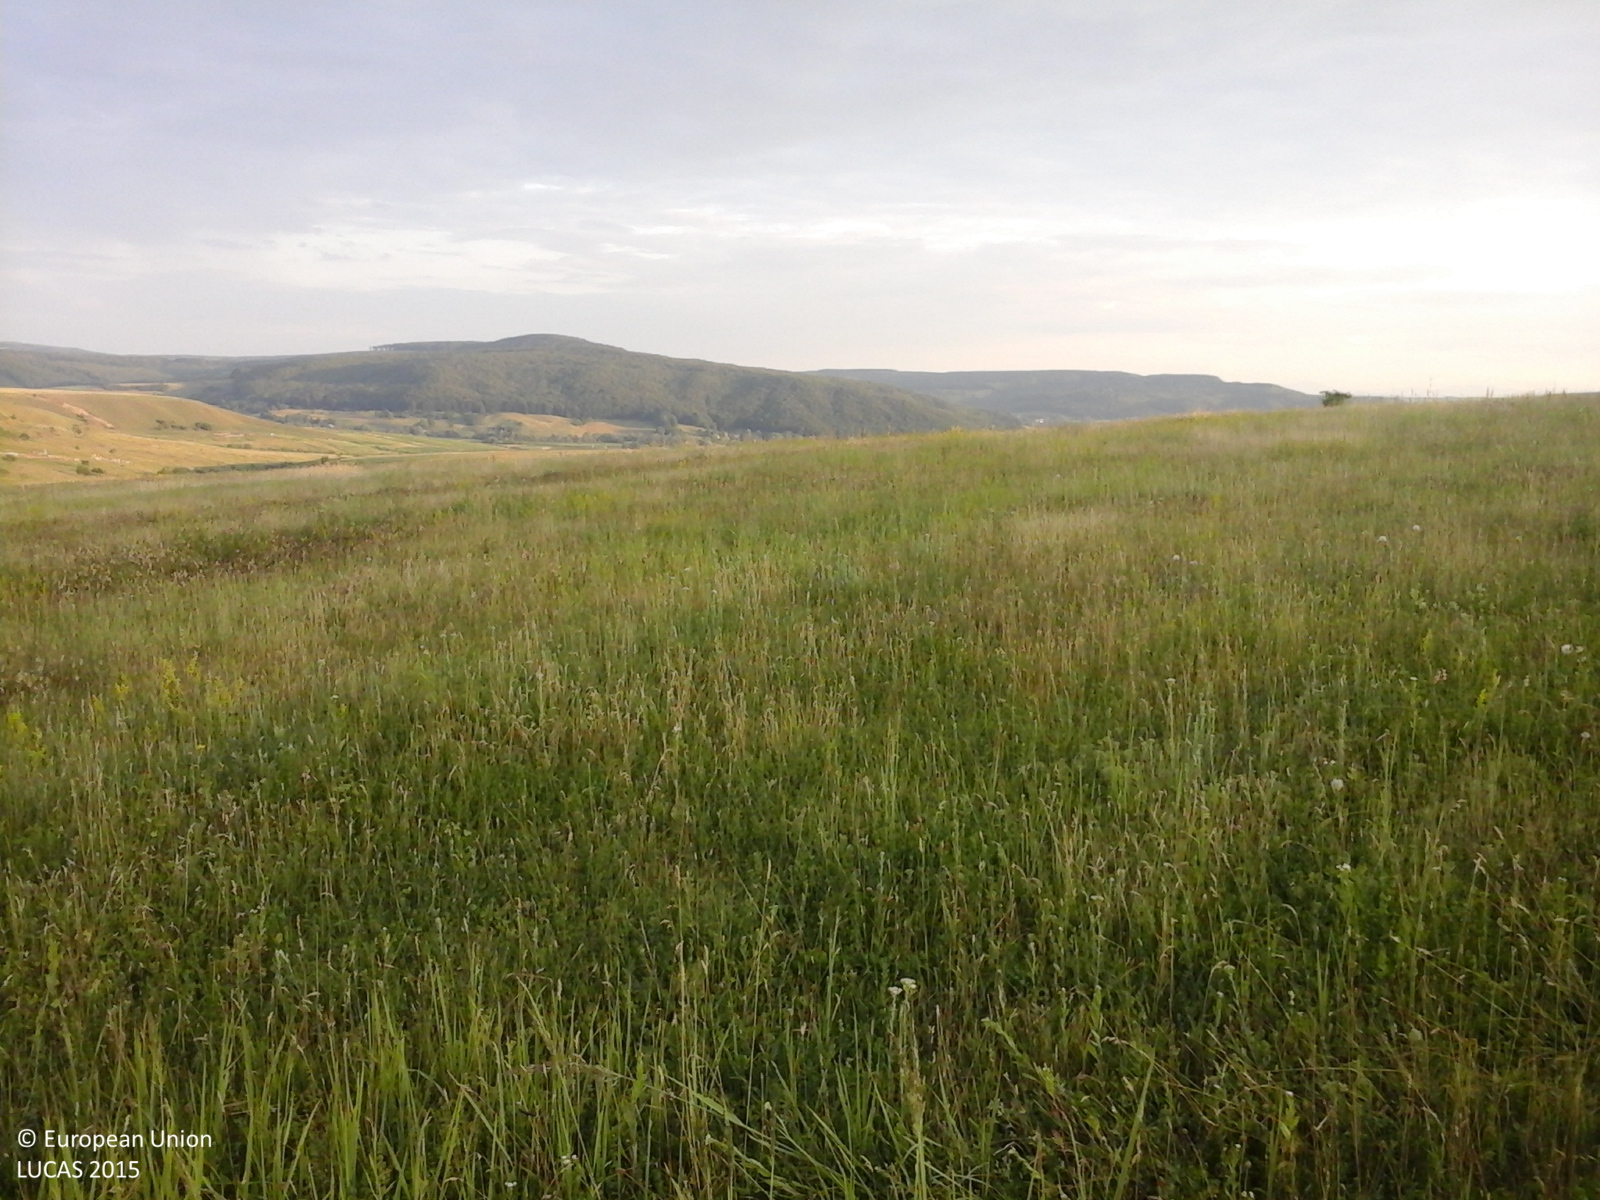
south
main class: Grassland
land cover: Grassland without tree/shrub cover
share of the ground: > 75 %
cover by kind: herbaceous plants 100 %
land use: Agriculture (excluding fallow land and kitchen gardens)
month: June
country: RO
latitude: 47.4607
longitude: 26.5251
